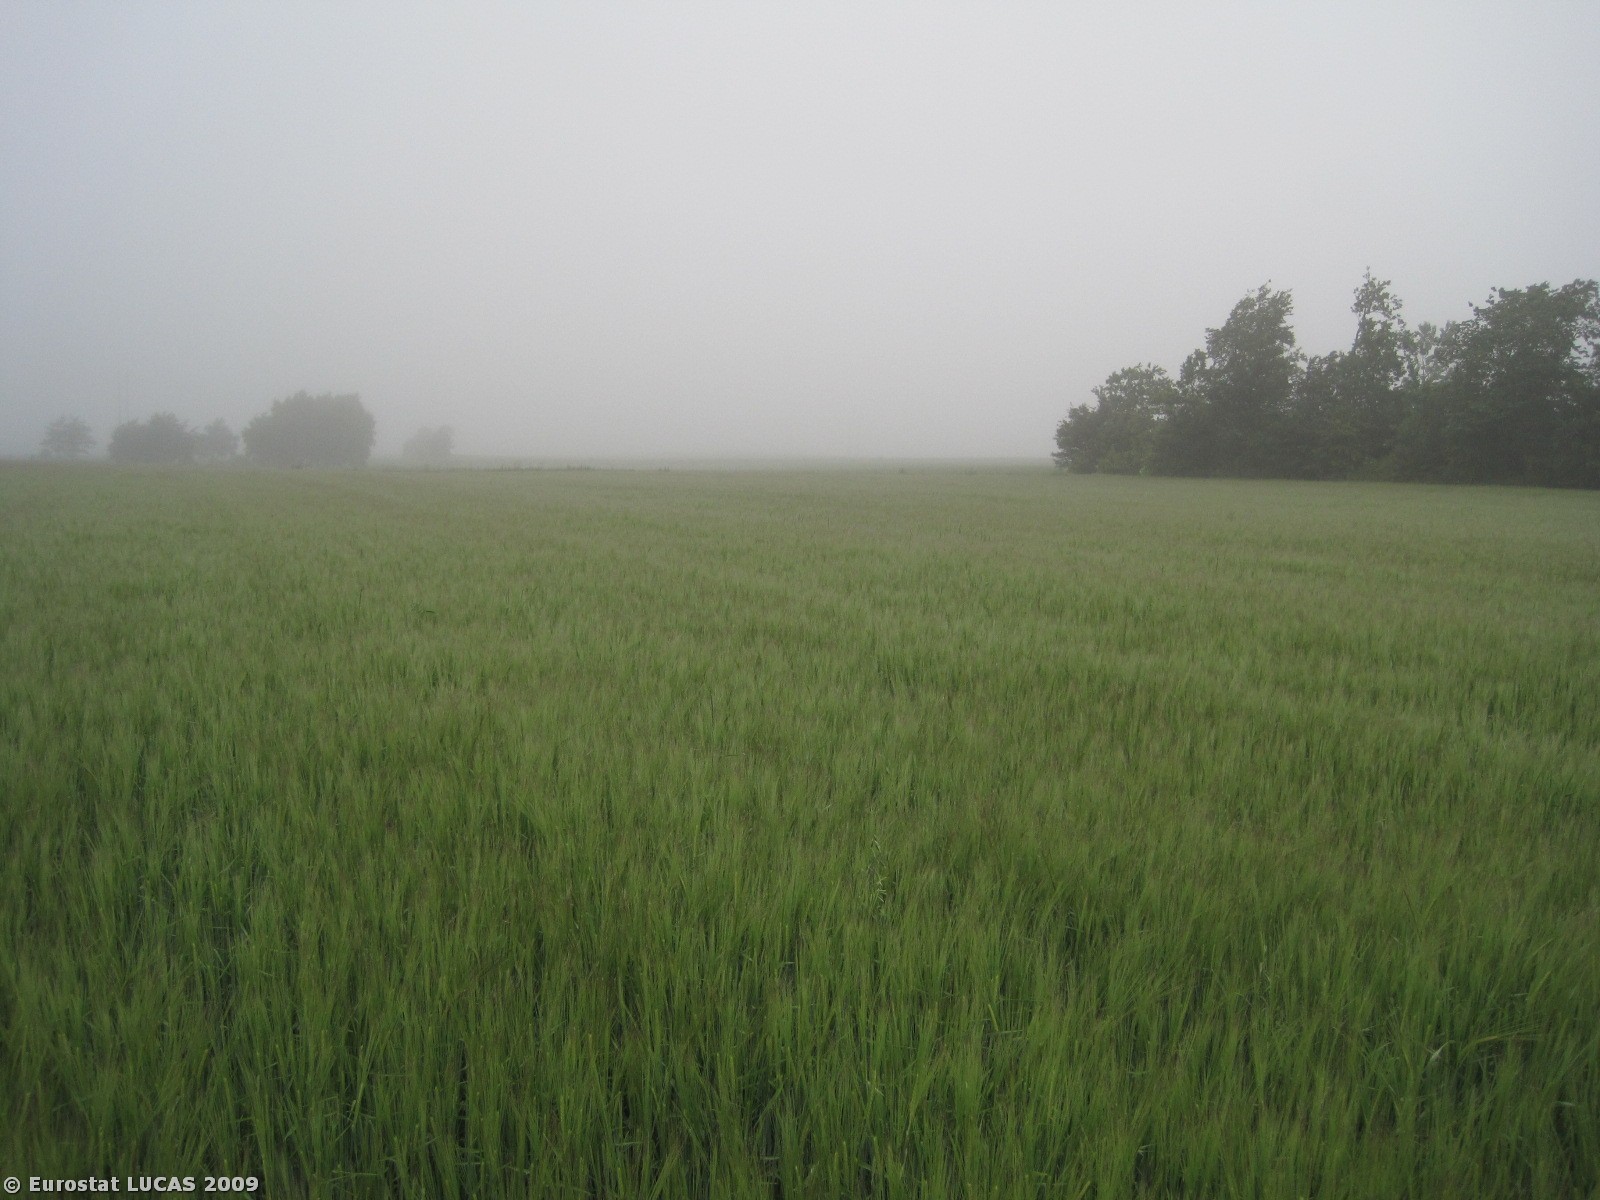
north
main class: Cropland
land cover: Barley
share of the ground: > 75 %
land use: Agriculture (excluding fallow land and kitchen gardens)
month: June
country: DK
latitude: 56.4893
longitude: 8.9781
